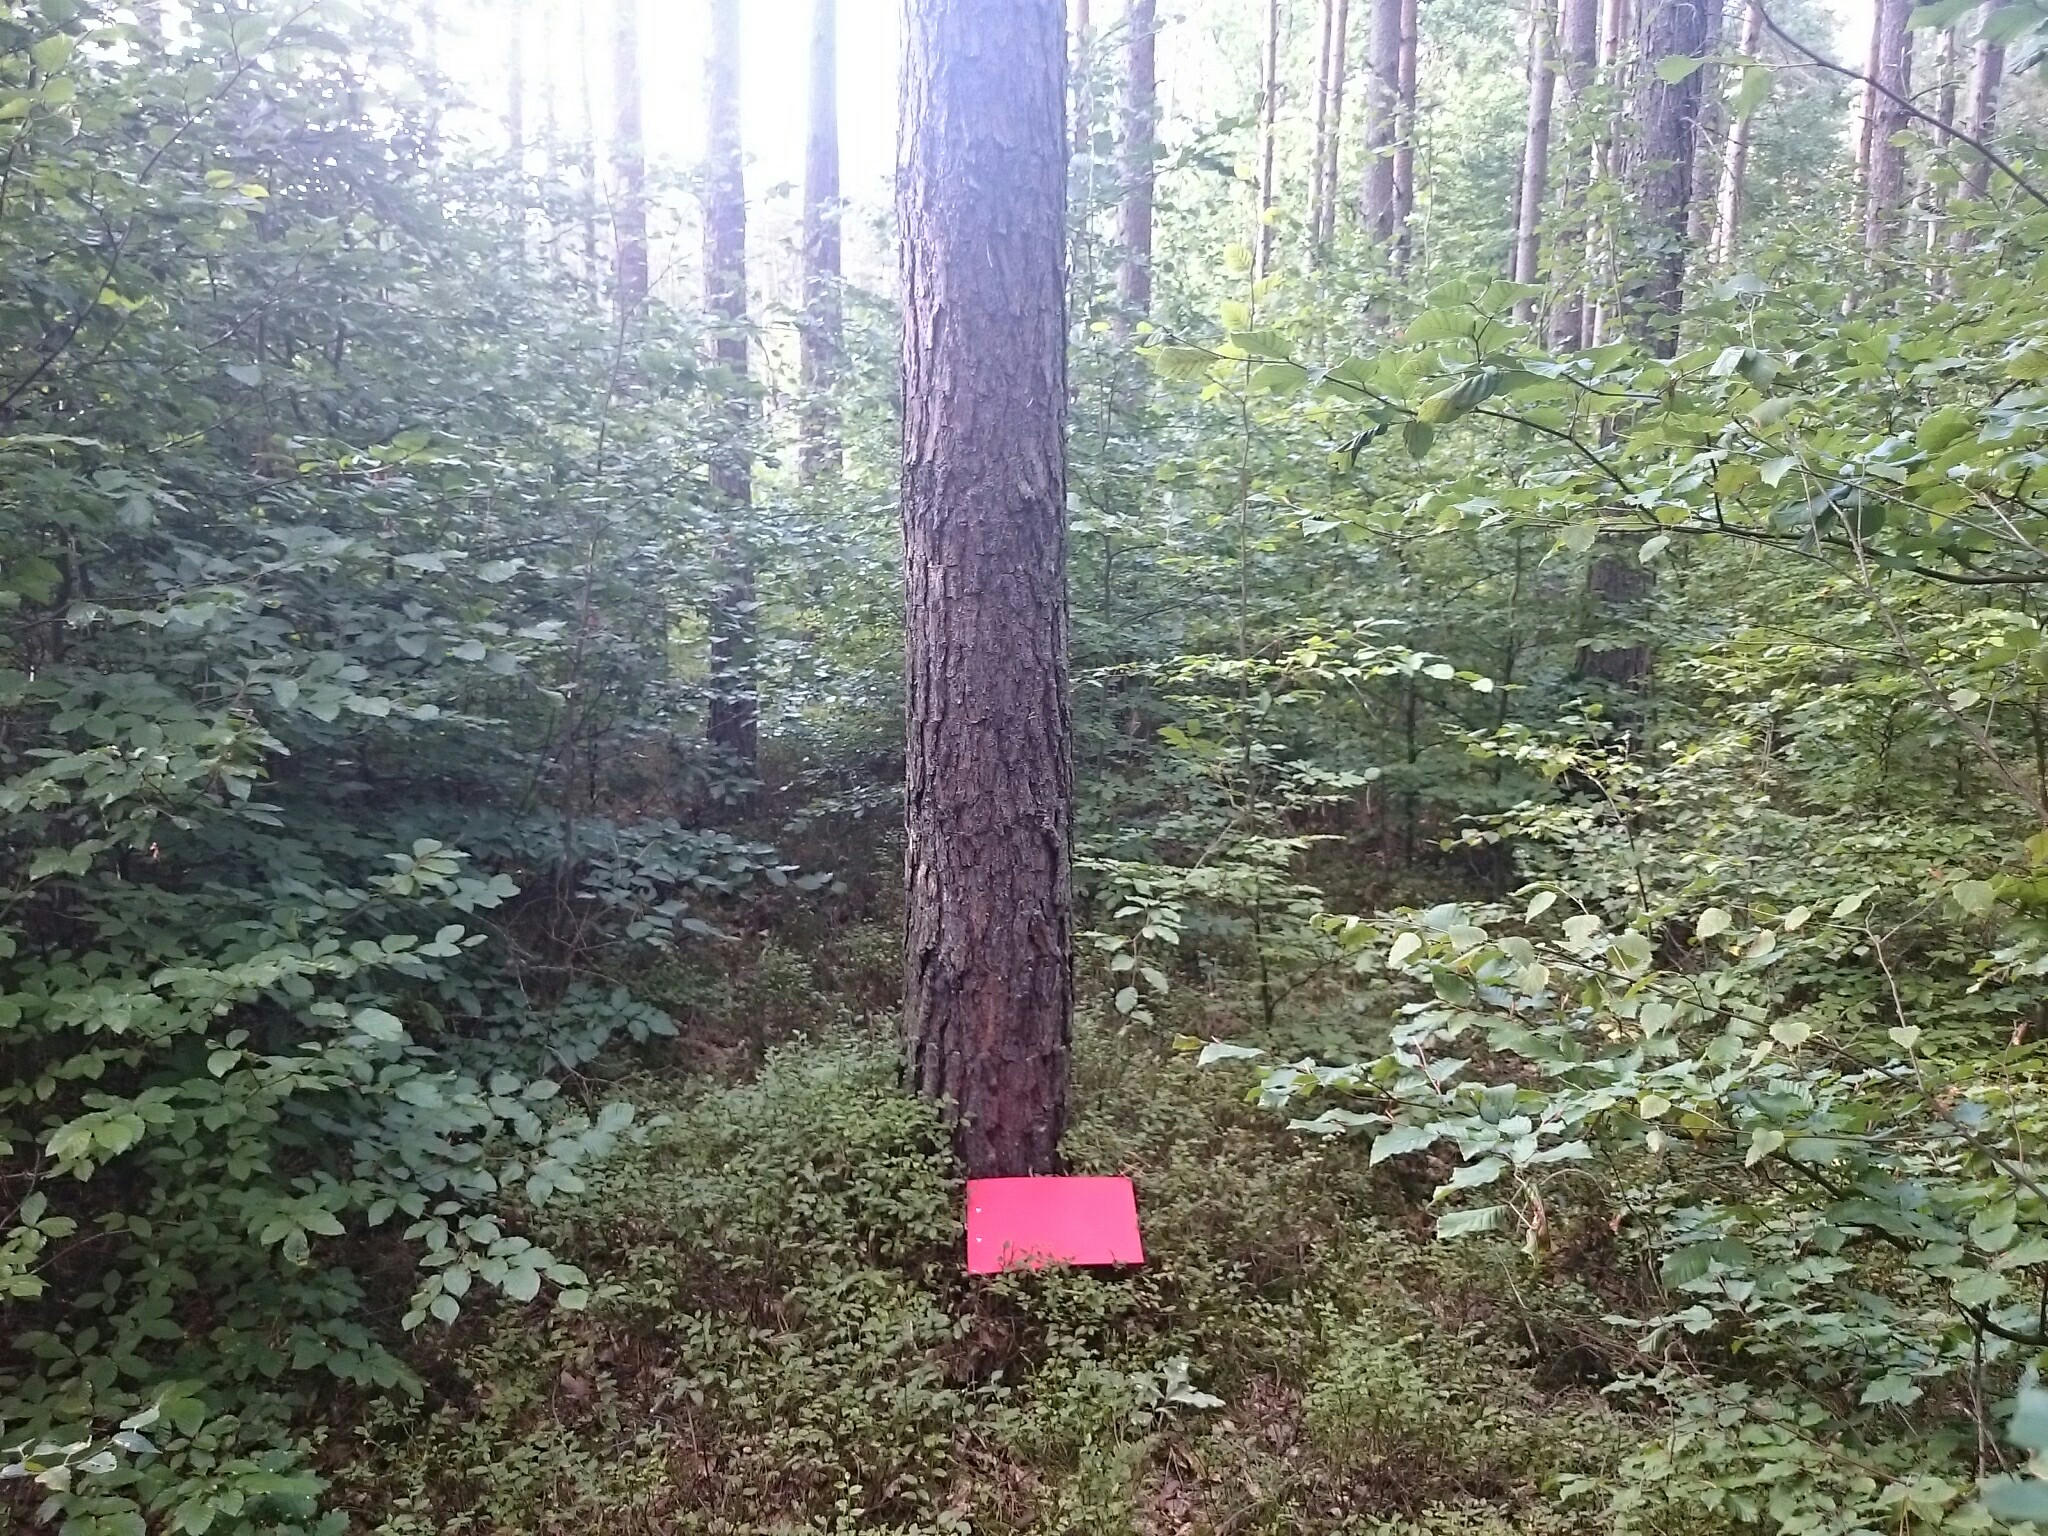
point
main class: Woodland
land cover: Pine dominated mixed woodland
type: hemiboreal forest and nemoral coniferous forest and mixed broadleaved-coniferous forest
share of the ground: > 75 %
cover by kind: coniferous forest trees 55 %, broadleaved forest trees 35 %, herbaceous plants 10 %
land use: Forestry
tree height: > 5 m
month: September
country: PL
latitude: 51.3749
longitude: 17.3242
